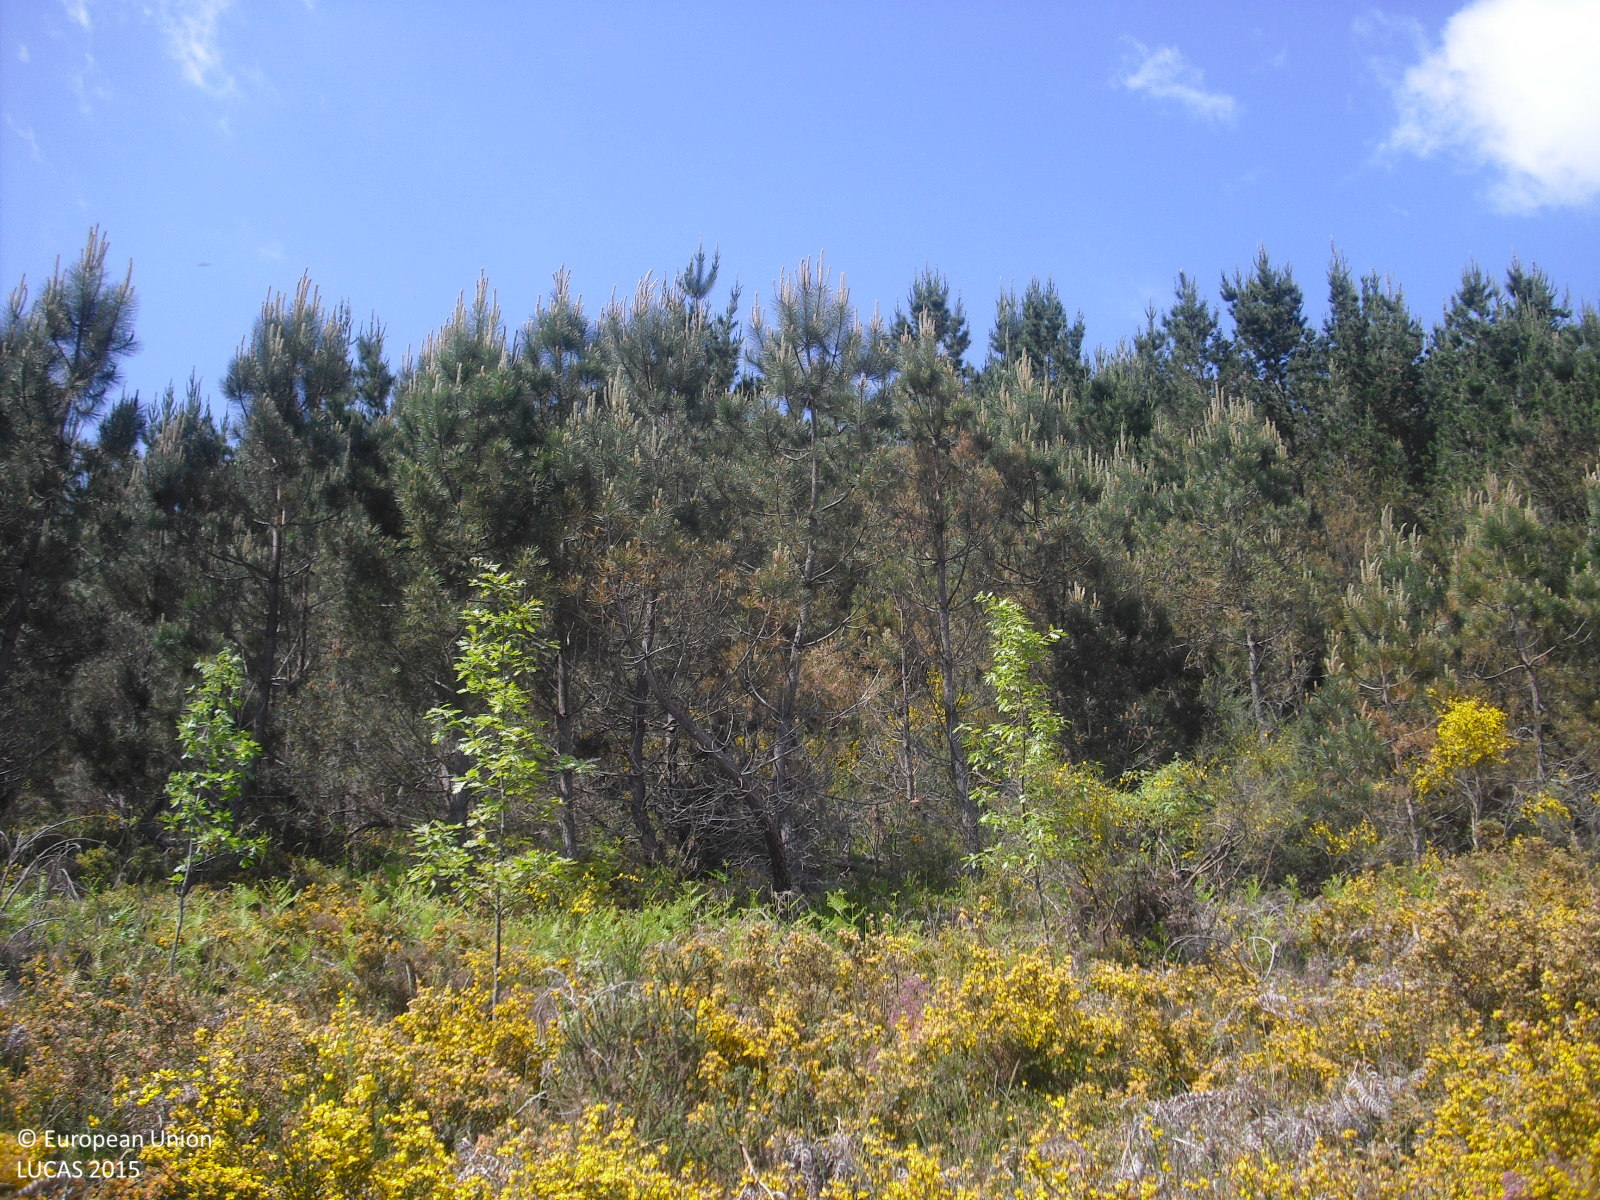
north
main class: Shrubland
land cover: Shrubland with sparse tree cover
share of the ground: > 75 %
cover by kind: shrubs 95 %, broadleaved forest trees 5 %
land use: Forestry
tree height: > 5 m
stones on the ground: < 10 %
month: May
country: ES
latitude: 42.1009
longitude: -7.5625
